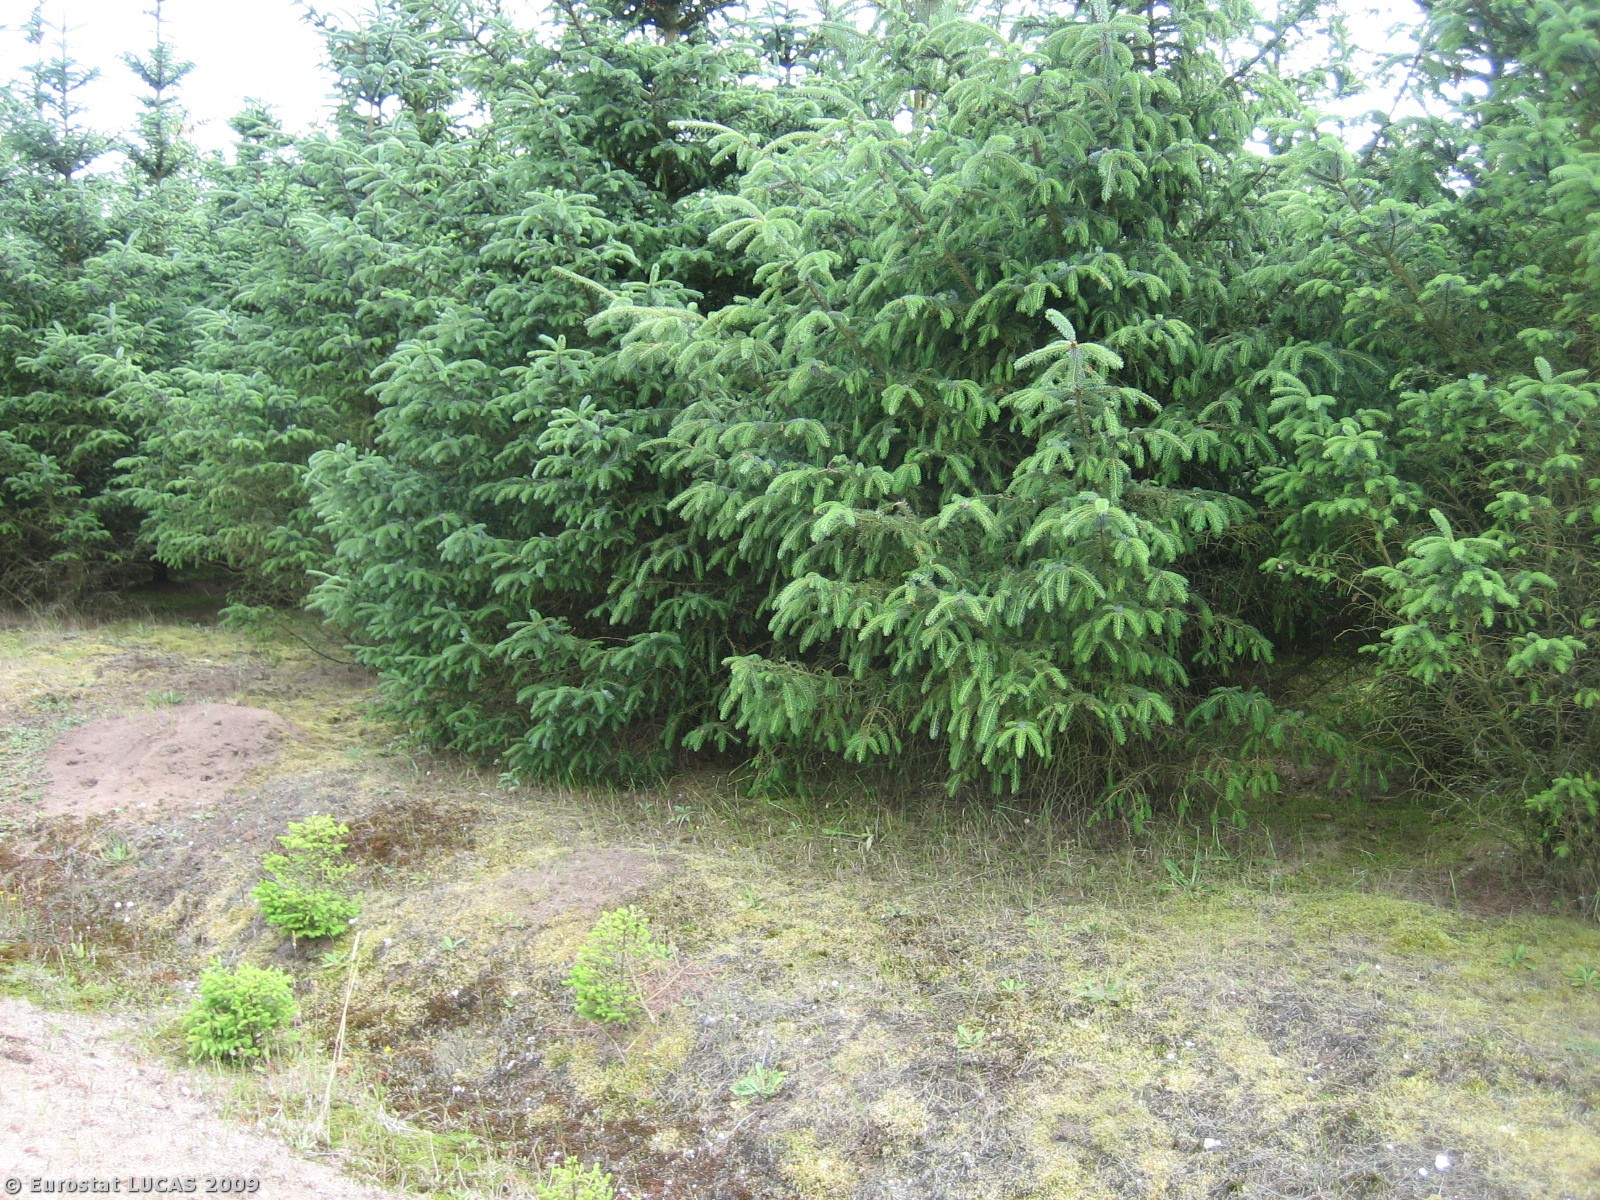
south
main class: Grassland
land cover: Grassland without tree/shrub cover
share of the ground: 50 - 75 %
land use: Forestry
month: July
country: DK
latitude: 55.8044
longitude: 8.7728
